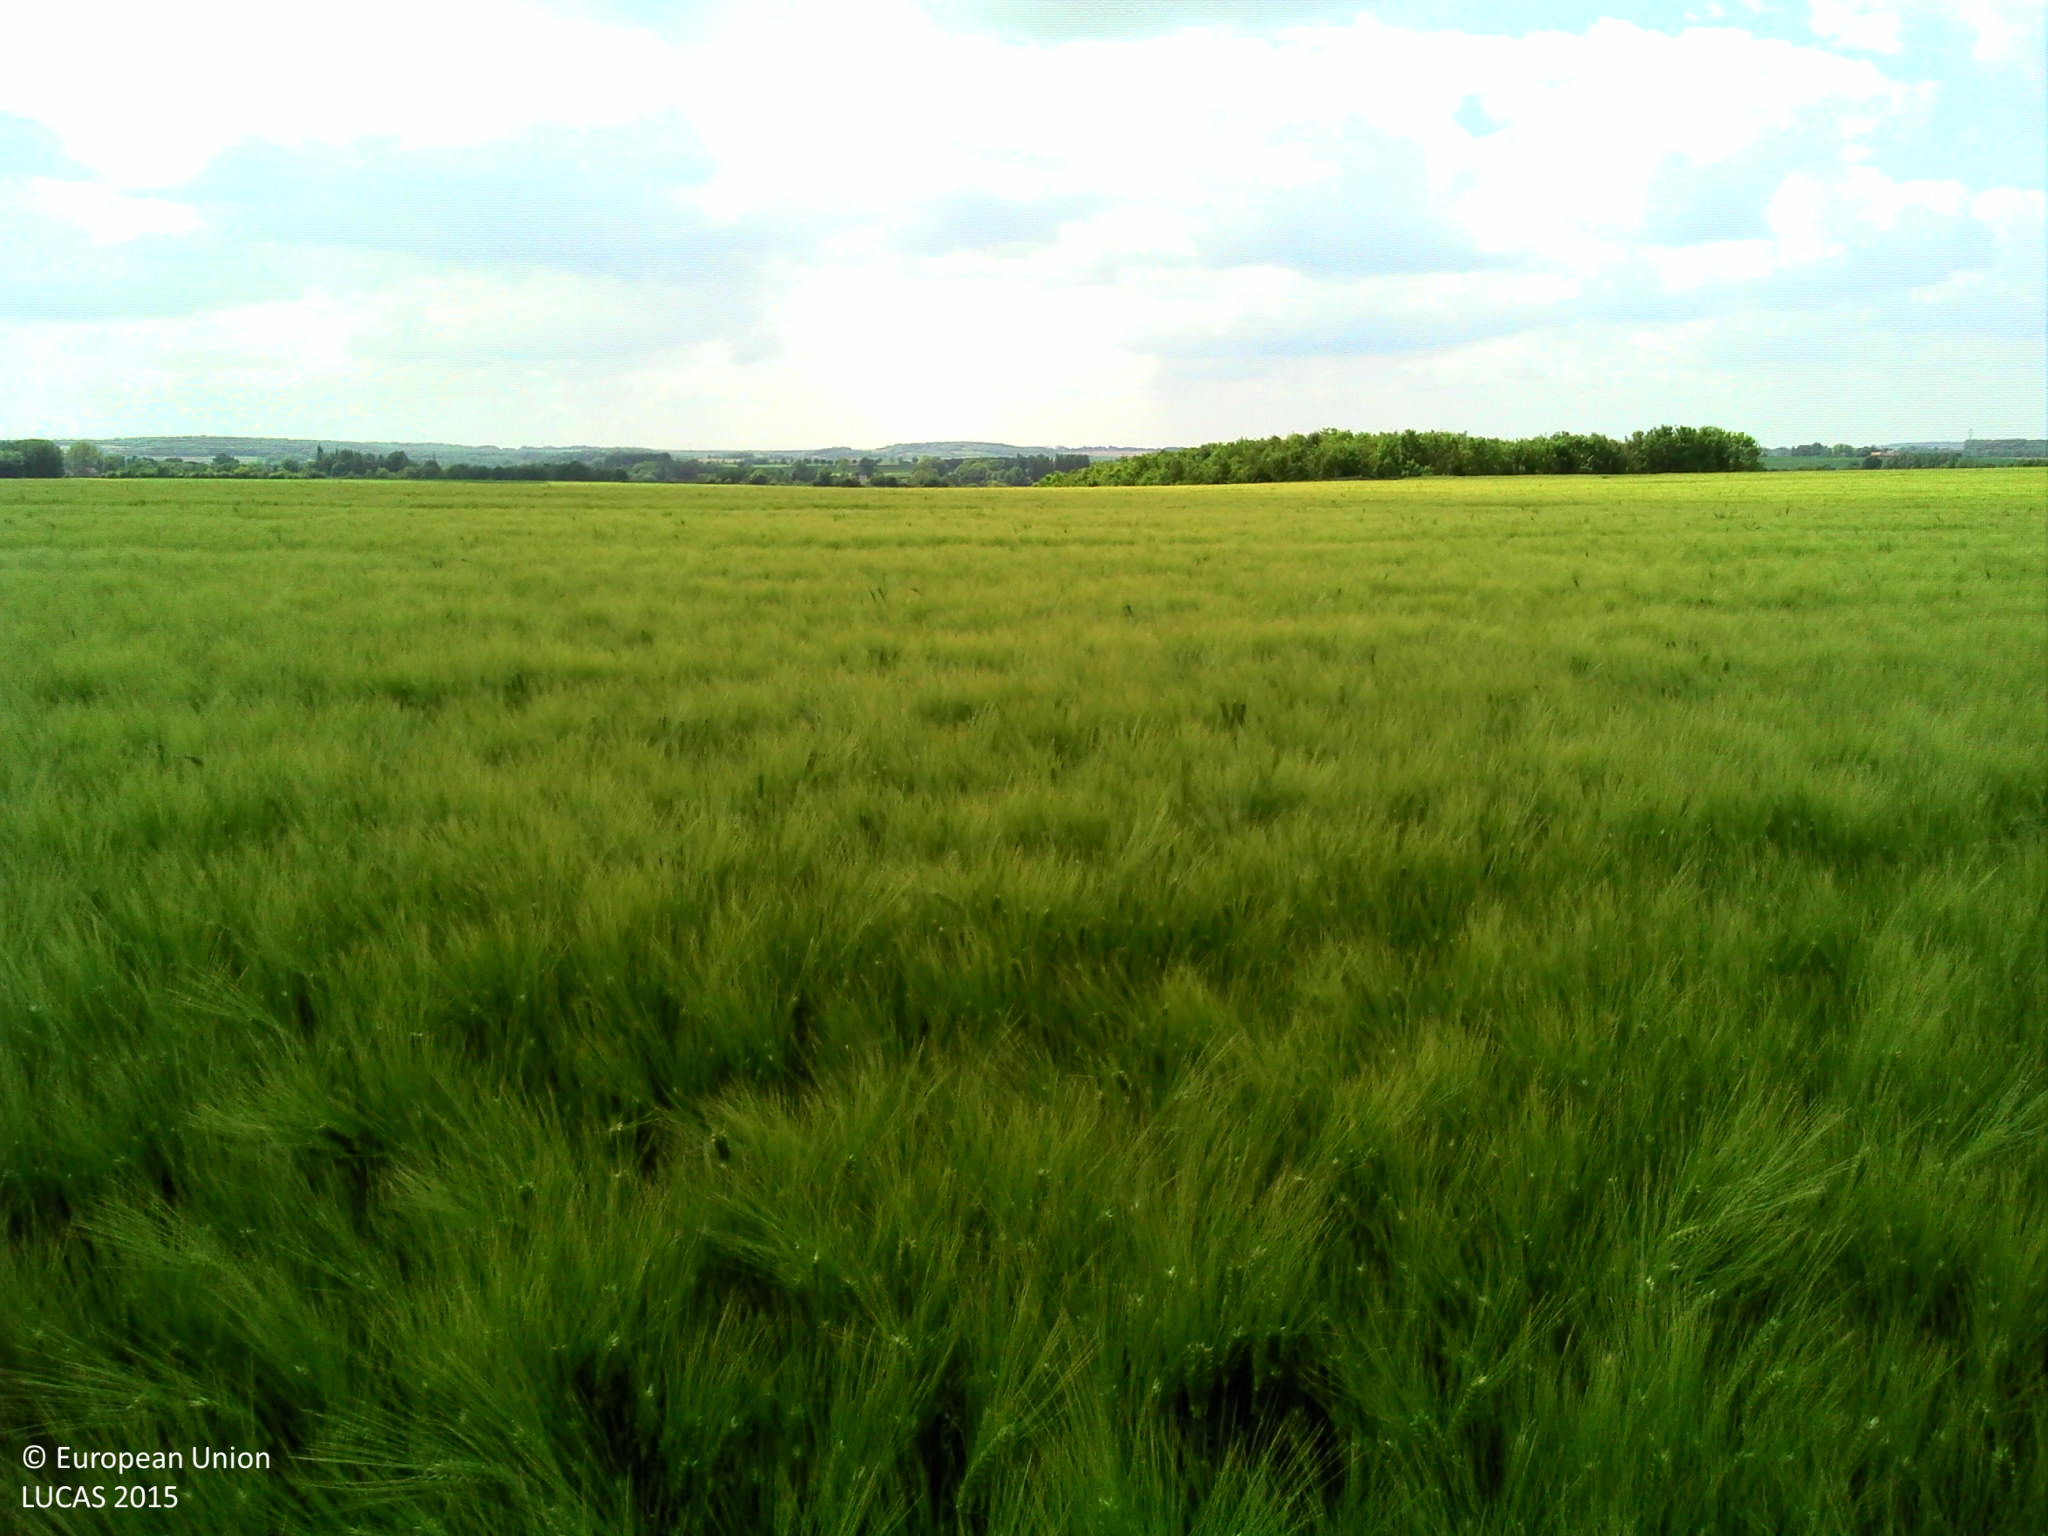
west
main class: Cropland
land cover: Barley
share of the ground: > 75 %
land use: Agriculture (excluding fallow land and kitchen gardens)
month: May
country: FR
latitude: 50.5469
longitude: 2.4369
